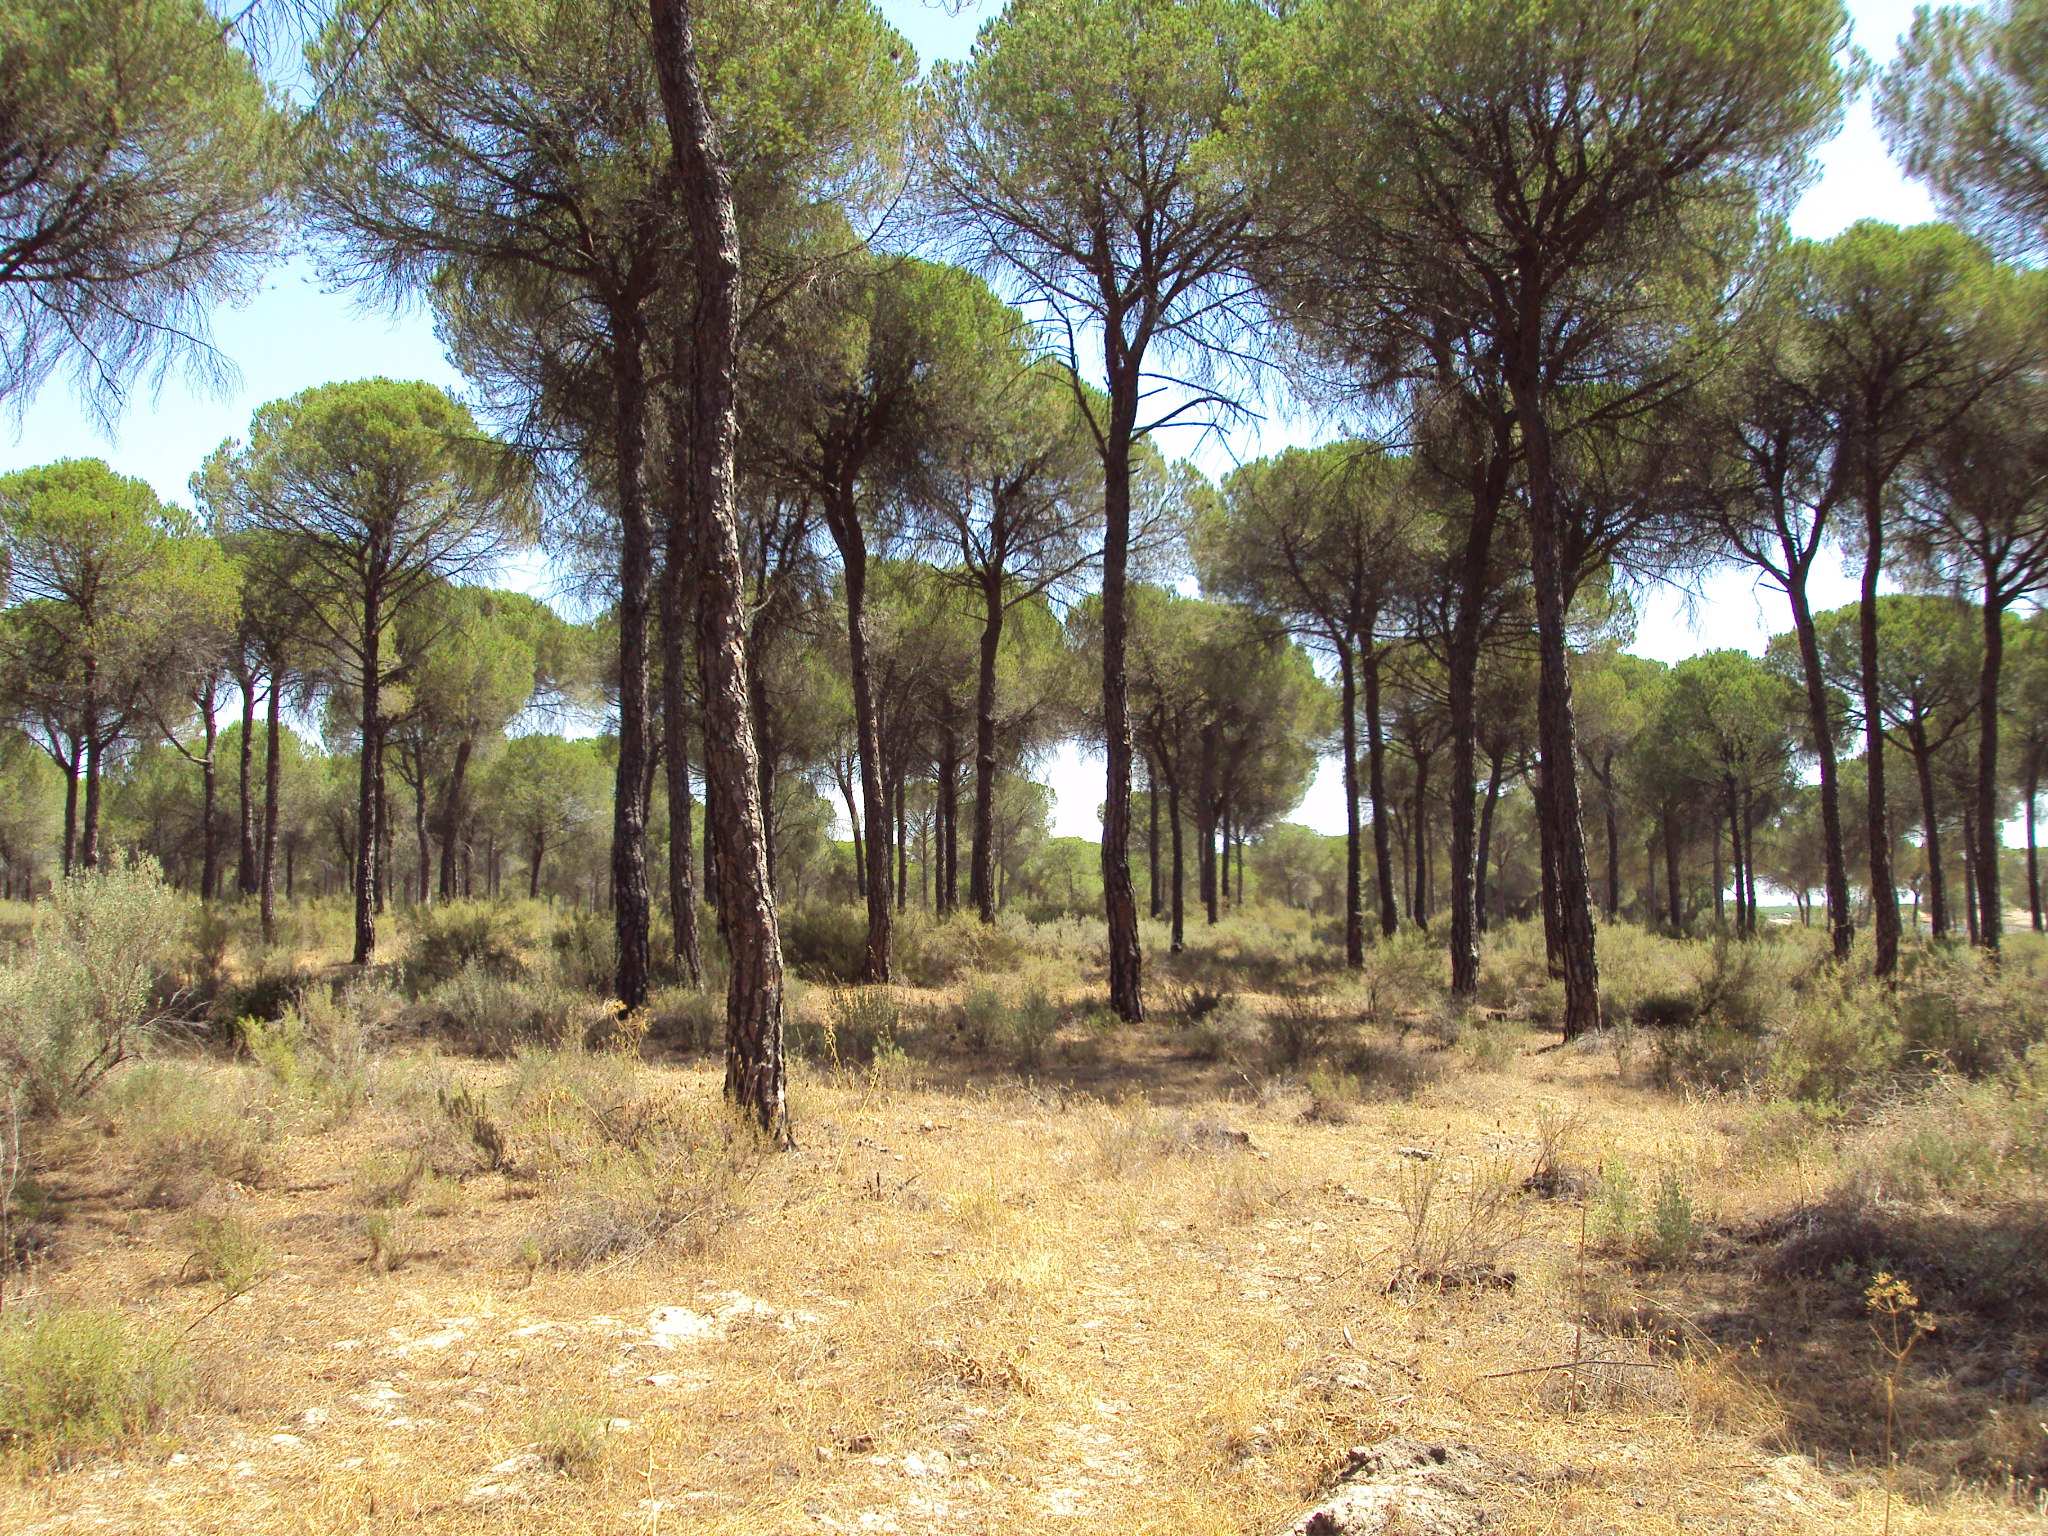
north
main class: Woodland
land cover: Pine dominated coniferous woodland
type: coniferous forest of the mediterranean region
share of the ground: 50 - 75 %
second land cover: Spontaneously vegetated surfaces
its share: > 75 %
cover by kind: coniferous forest trees 60 %, shrubs 30 %, herbaceous plants 10 %
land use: Forestry
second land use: Agriculture (excluding fallow land and kitchen gardens)
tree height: > 5 m
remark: Clear cut
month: July
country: ES
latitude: 37.2255
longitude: -6.5640
